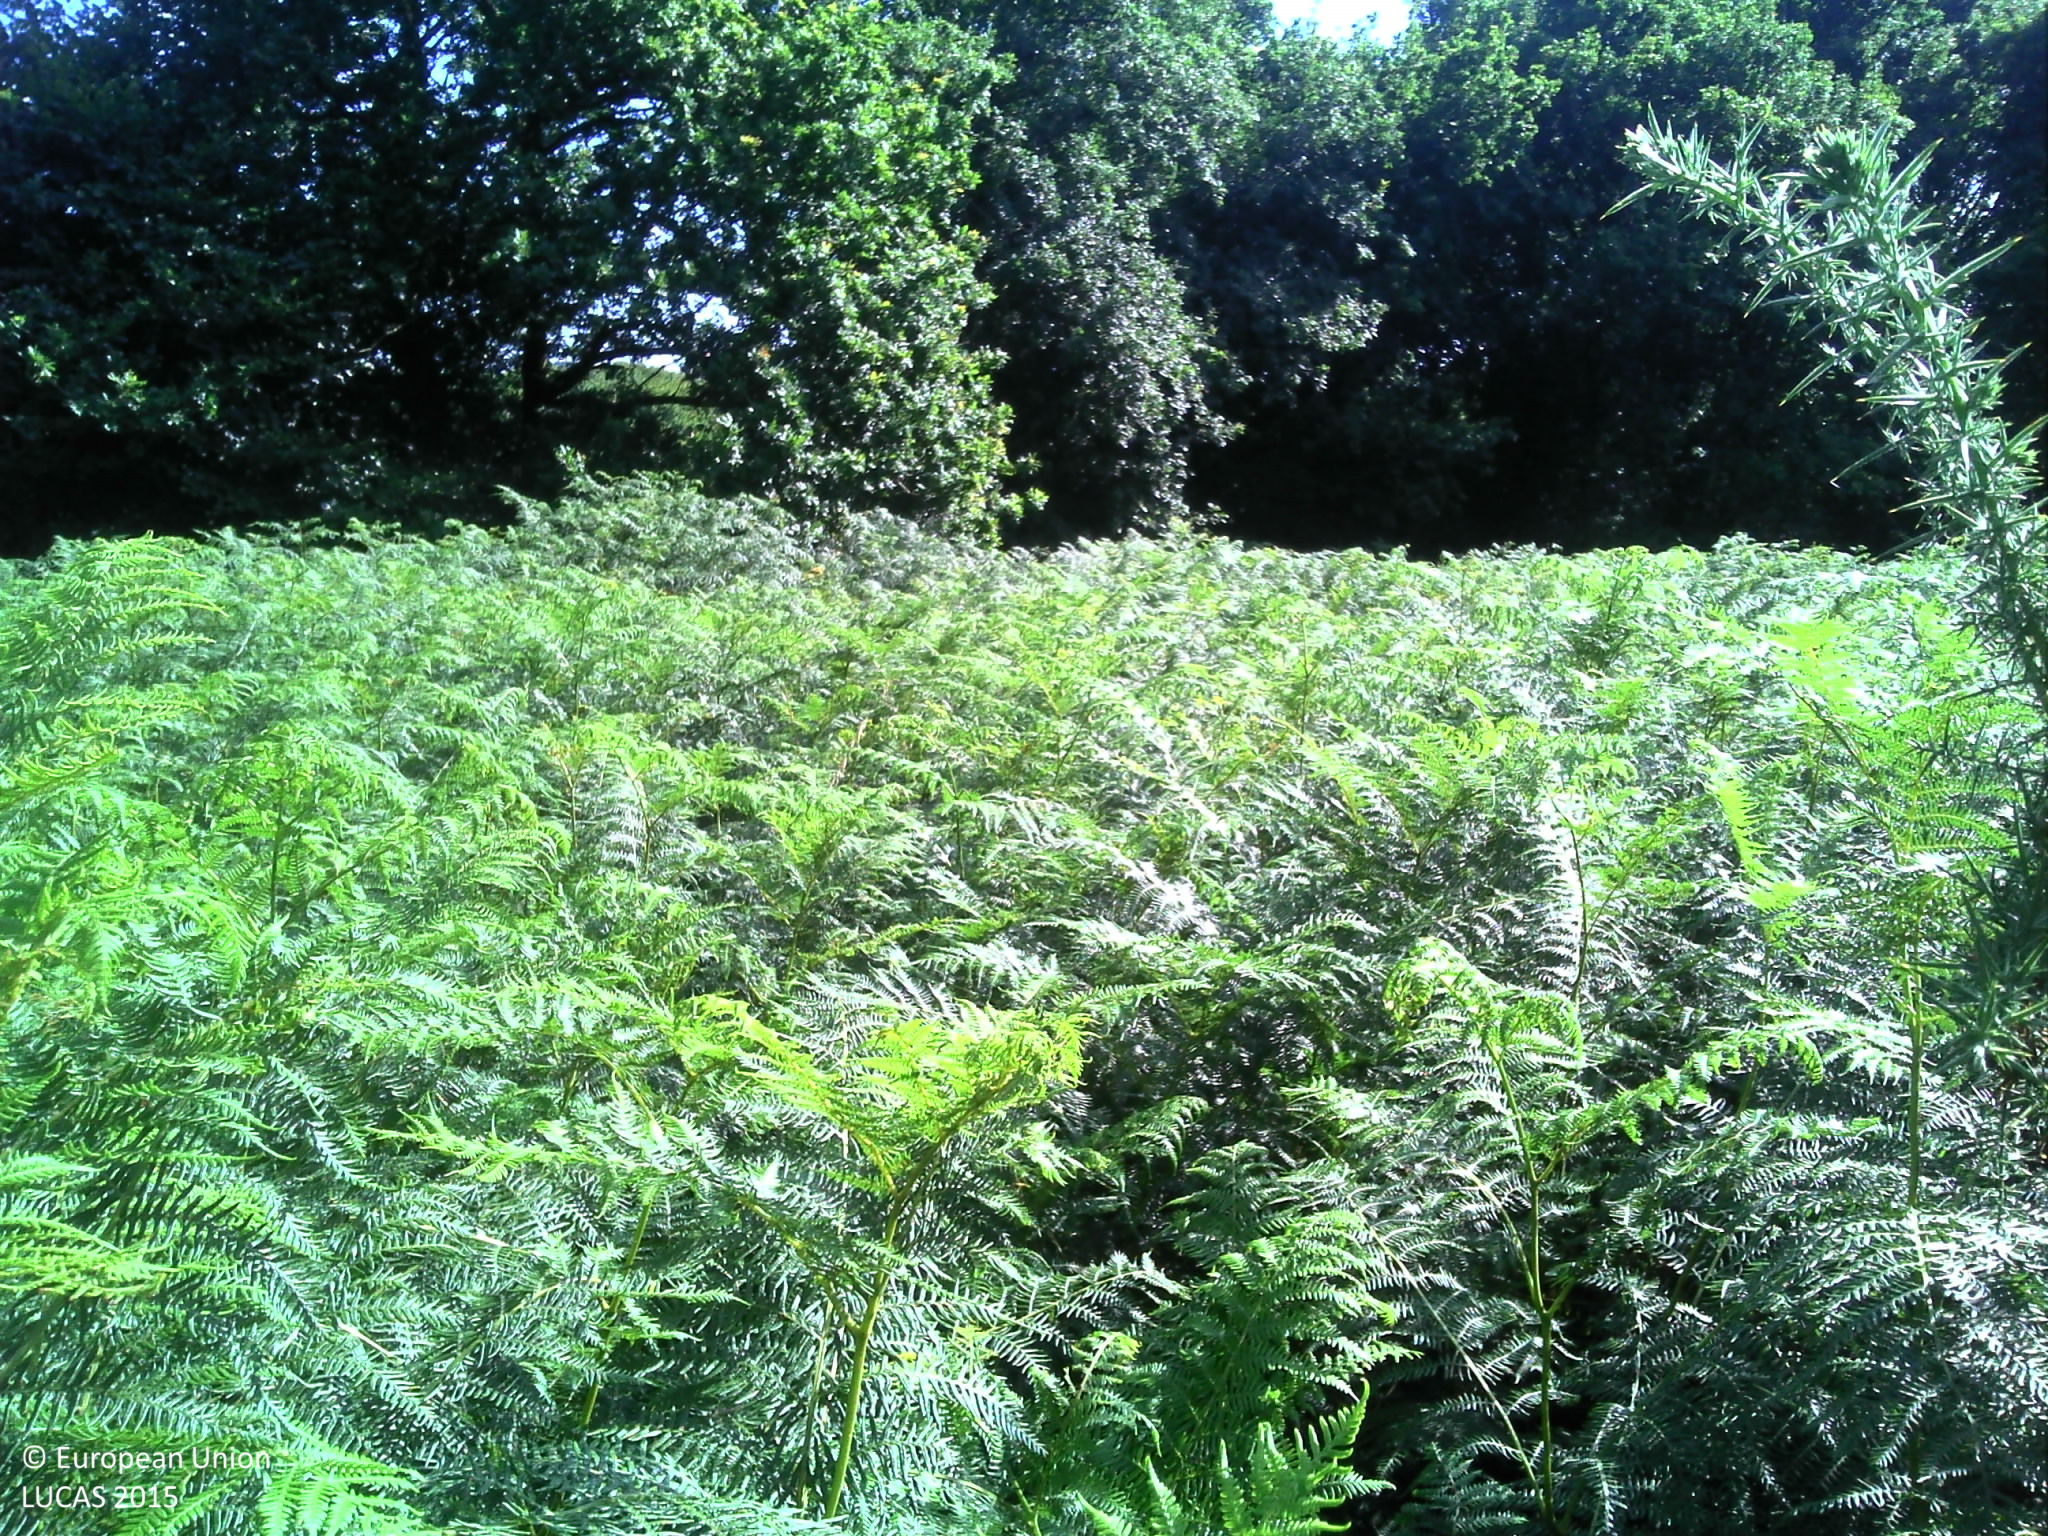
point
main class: Grassland
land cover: Spontaneously vegetated surfaces
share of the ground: > 75 %
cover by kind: herbaceous plants 95 %, shrubs 5 %
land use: Semi-natural and natural areas not in use
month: August
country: FR
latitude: 48.4270
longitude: -3.3607
